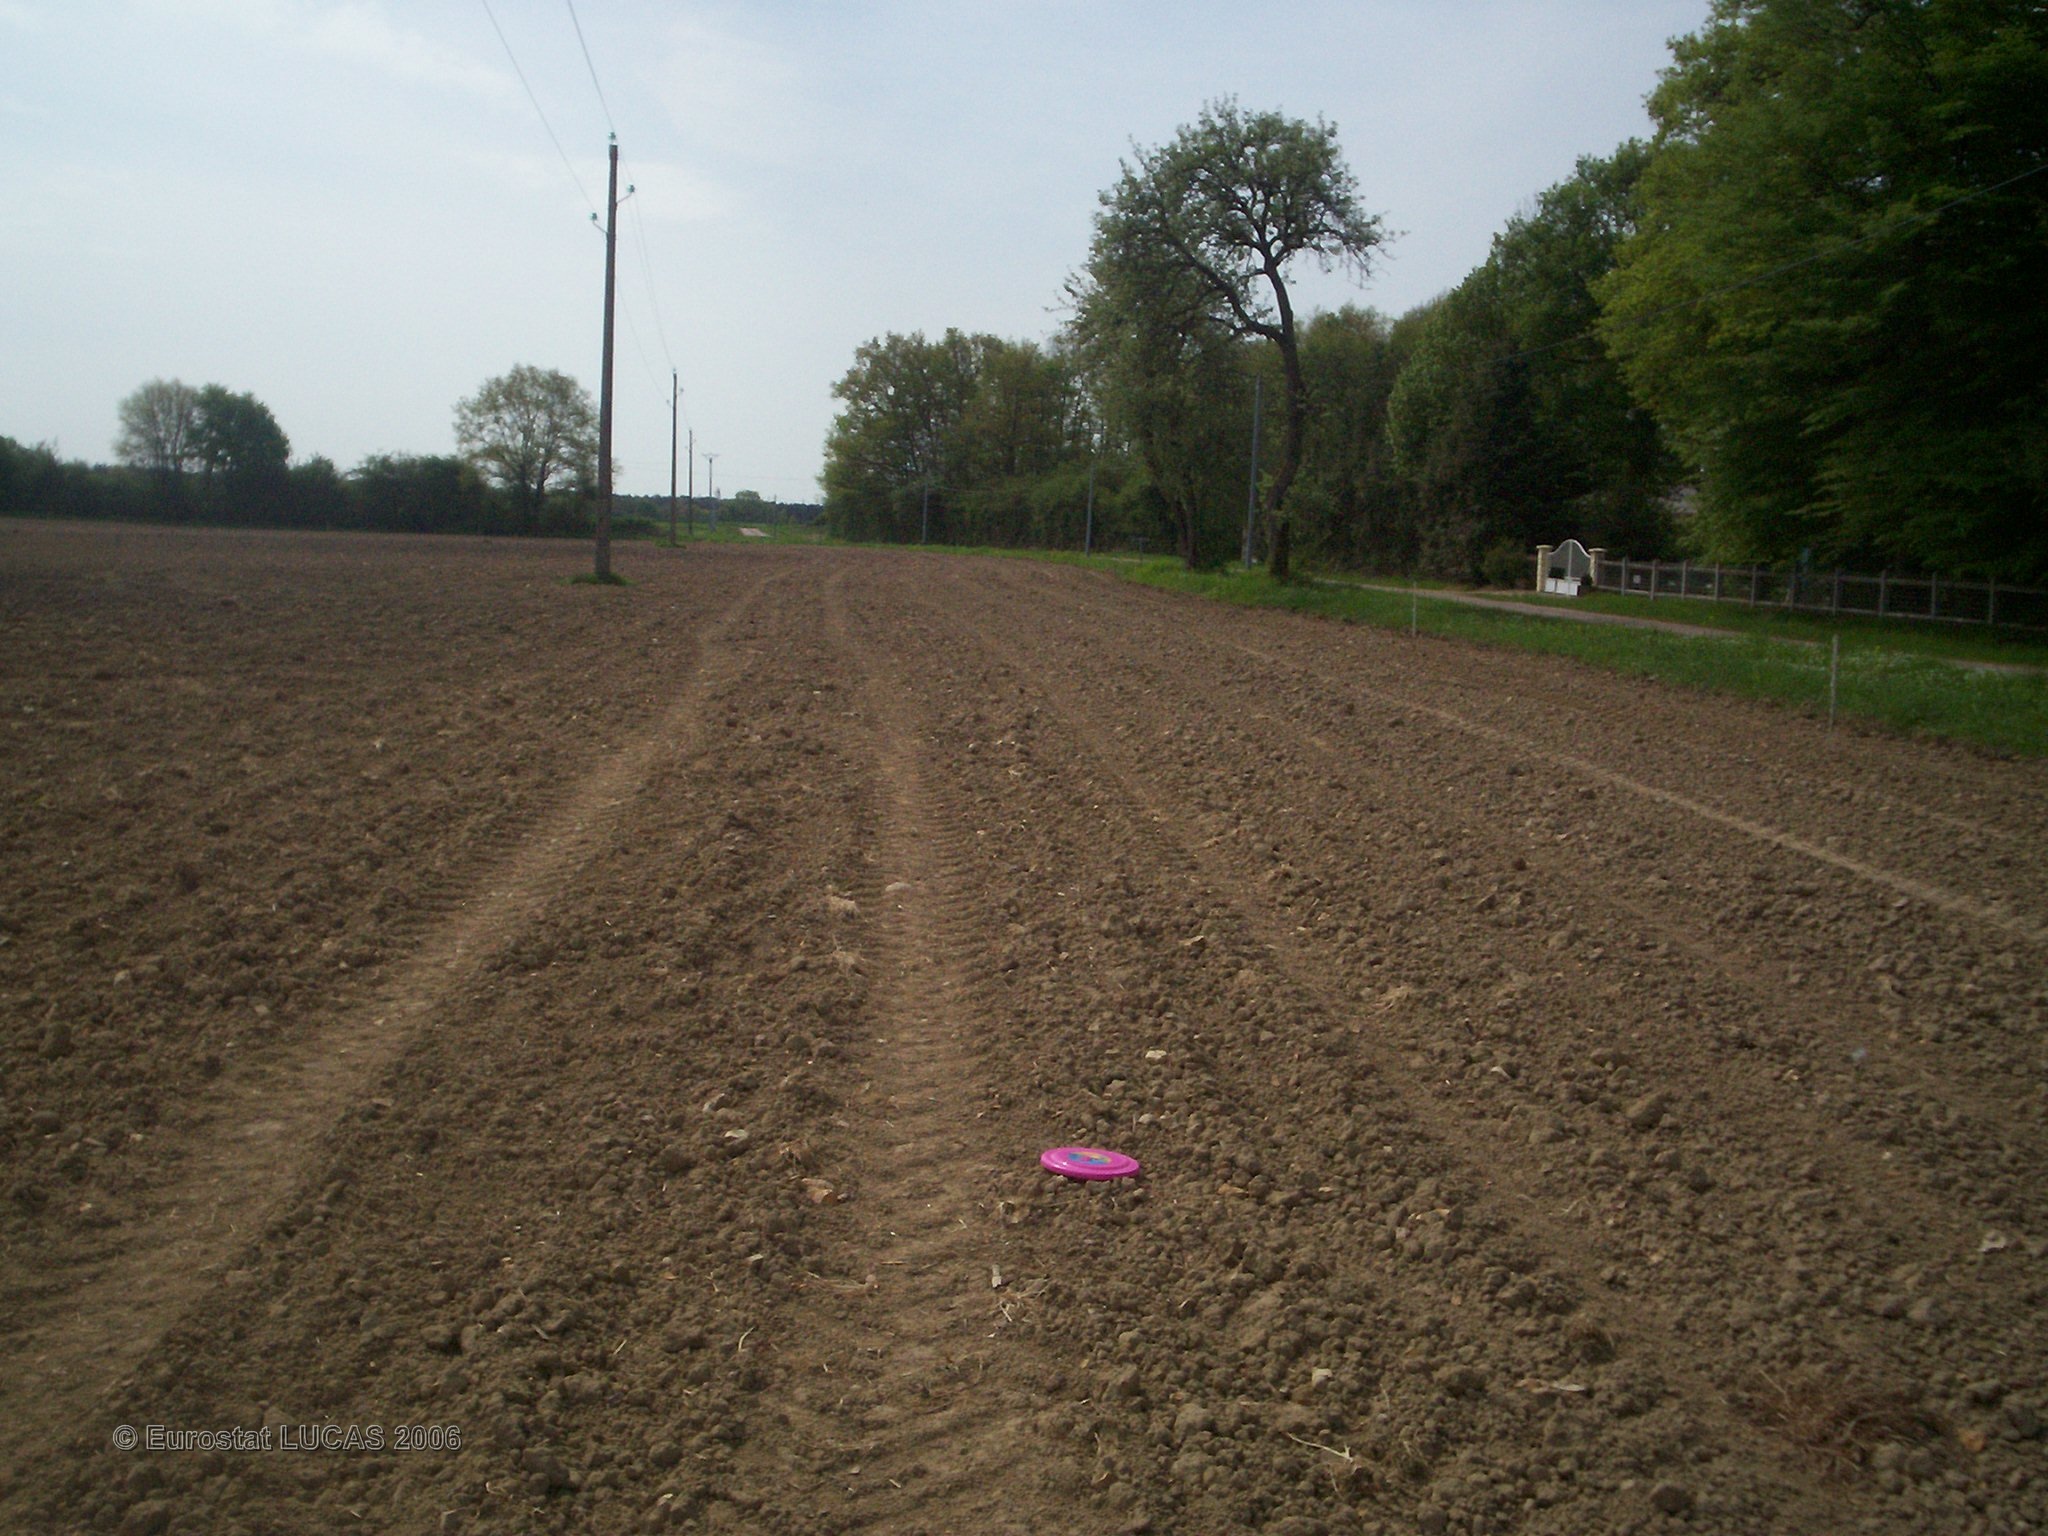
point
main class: Cropland
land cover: Maize
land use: Agriculture (excluding fallow land and kitchen gardens)
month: June
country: FR
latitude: 47.5991
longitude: 2.9313
